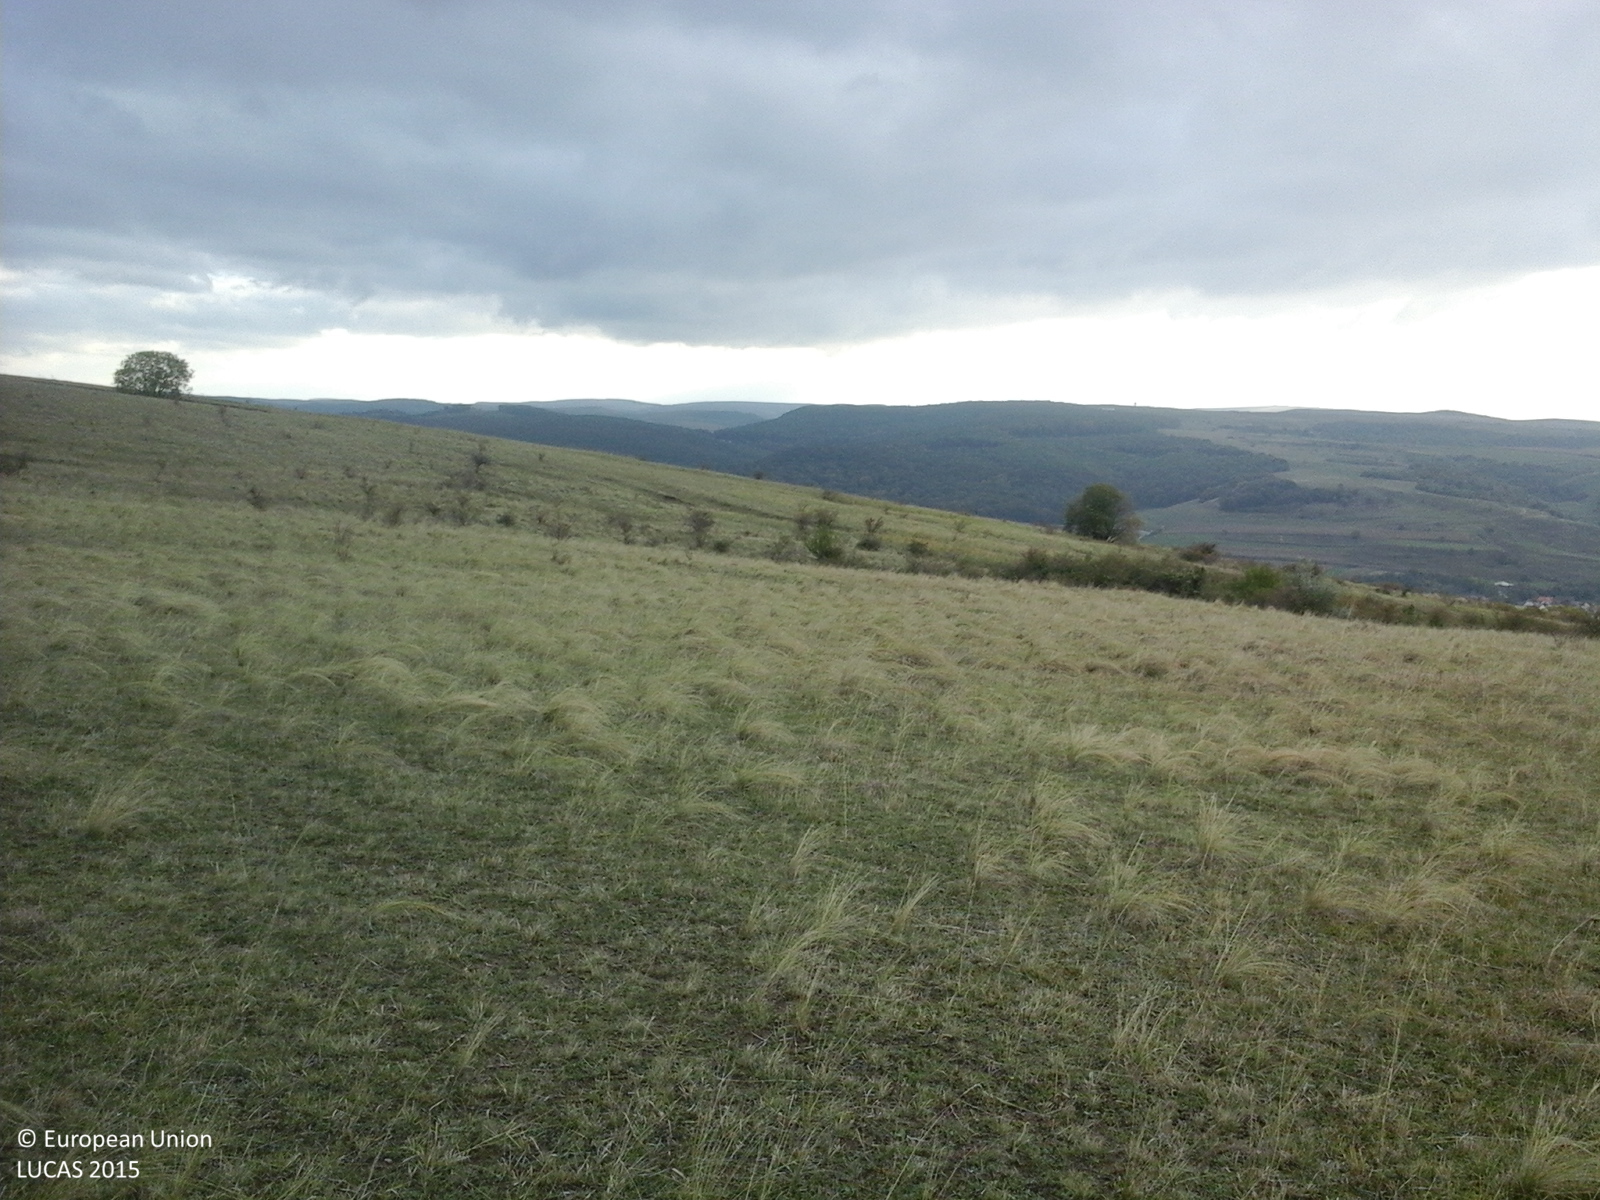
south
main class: Grassland
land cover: Grassland without tree/shrub cover
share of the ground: > 75 %
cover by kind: herbaceous plants 100 %
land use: Agriculture (excluding fallow land and kitchen gardens)
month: October
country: RO
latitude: 45.9670
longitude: 24.1816
